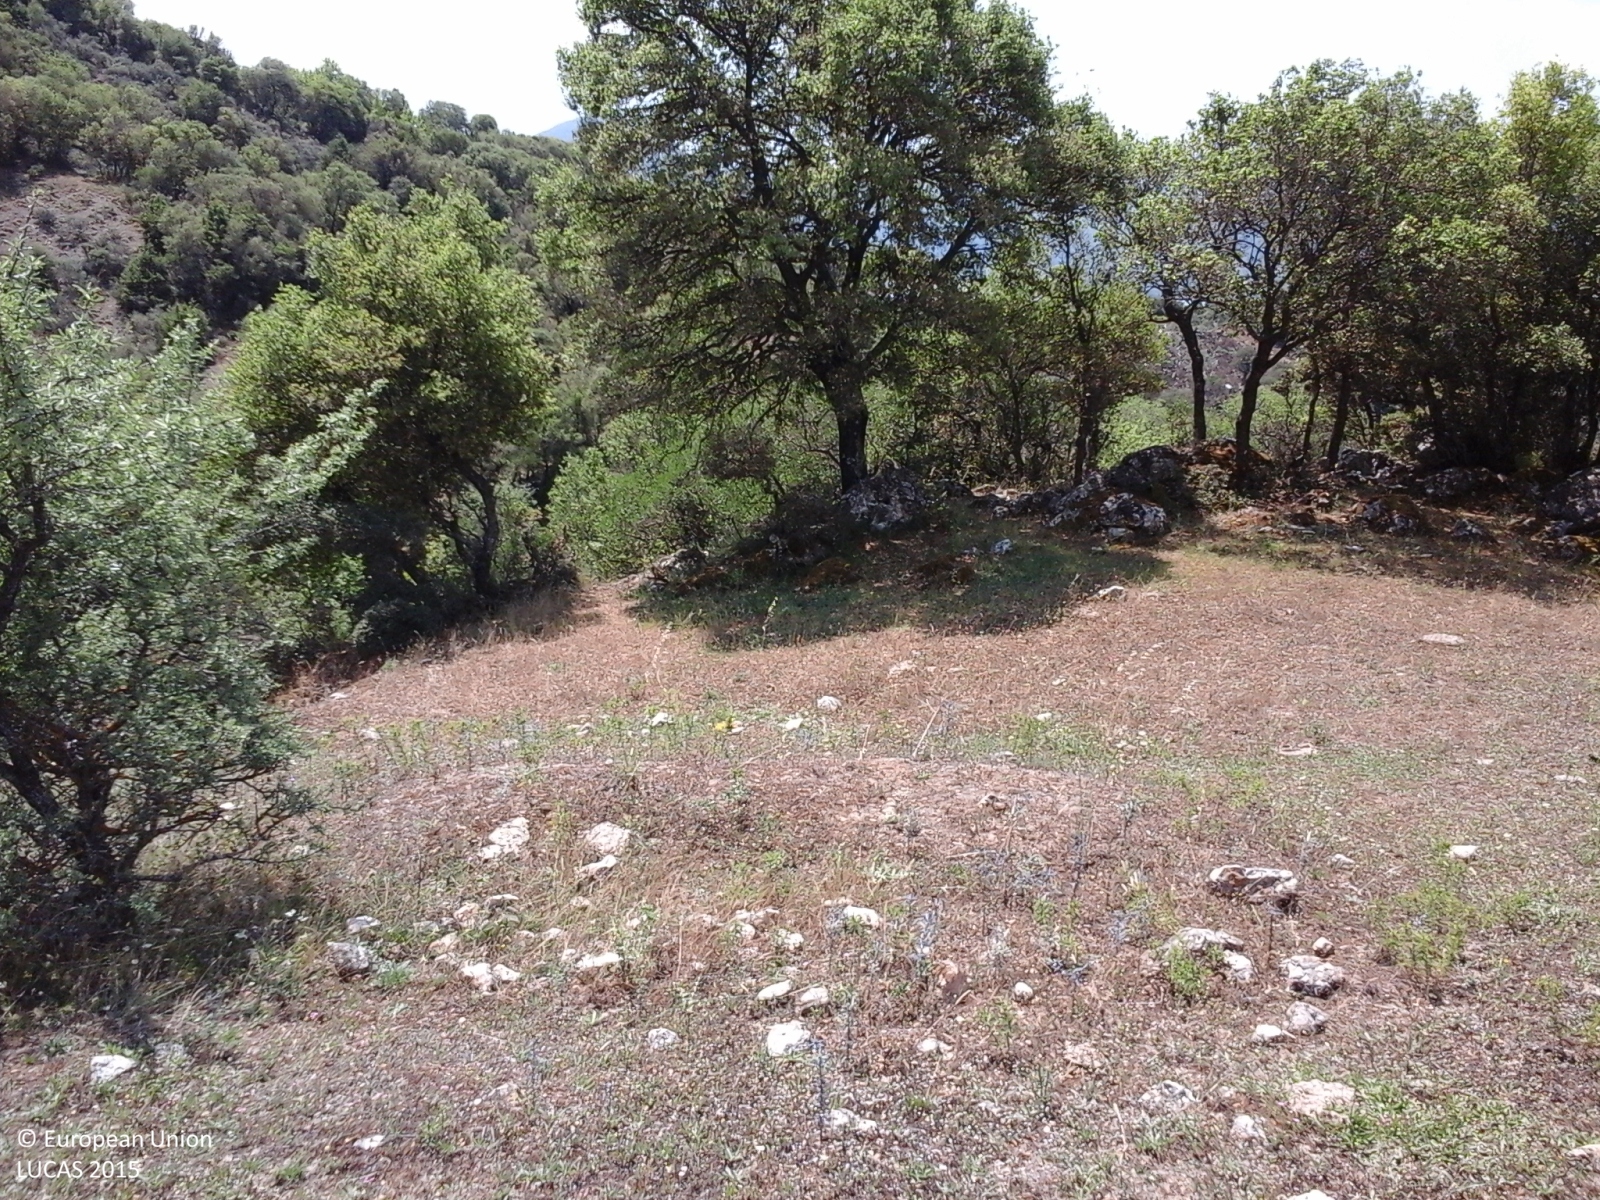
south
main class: Grassland
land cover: Grassland with sparse tree/shrub cover
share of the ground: > 75 %
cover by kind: herbaceous plants 75 %, unconsolidated bare surface 15 %, broadleaved forest trees 5 %, shrubs 5 %
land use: Agriculture (excluding fallow land and kitchen gardens)
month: July
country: GR
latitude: 38.5583
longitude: 22.1498
